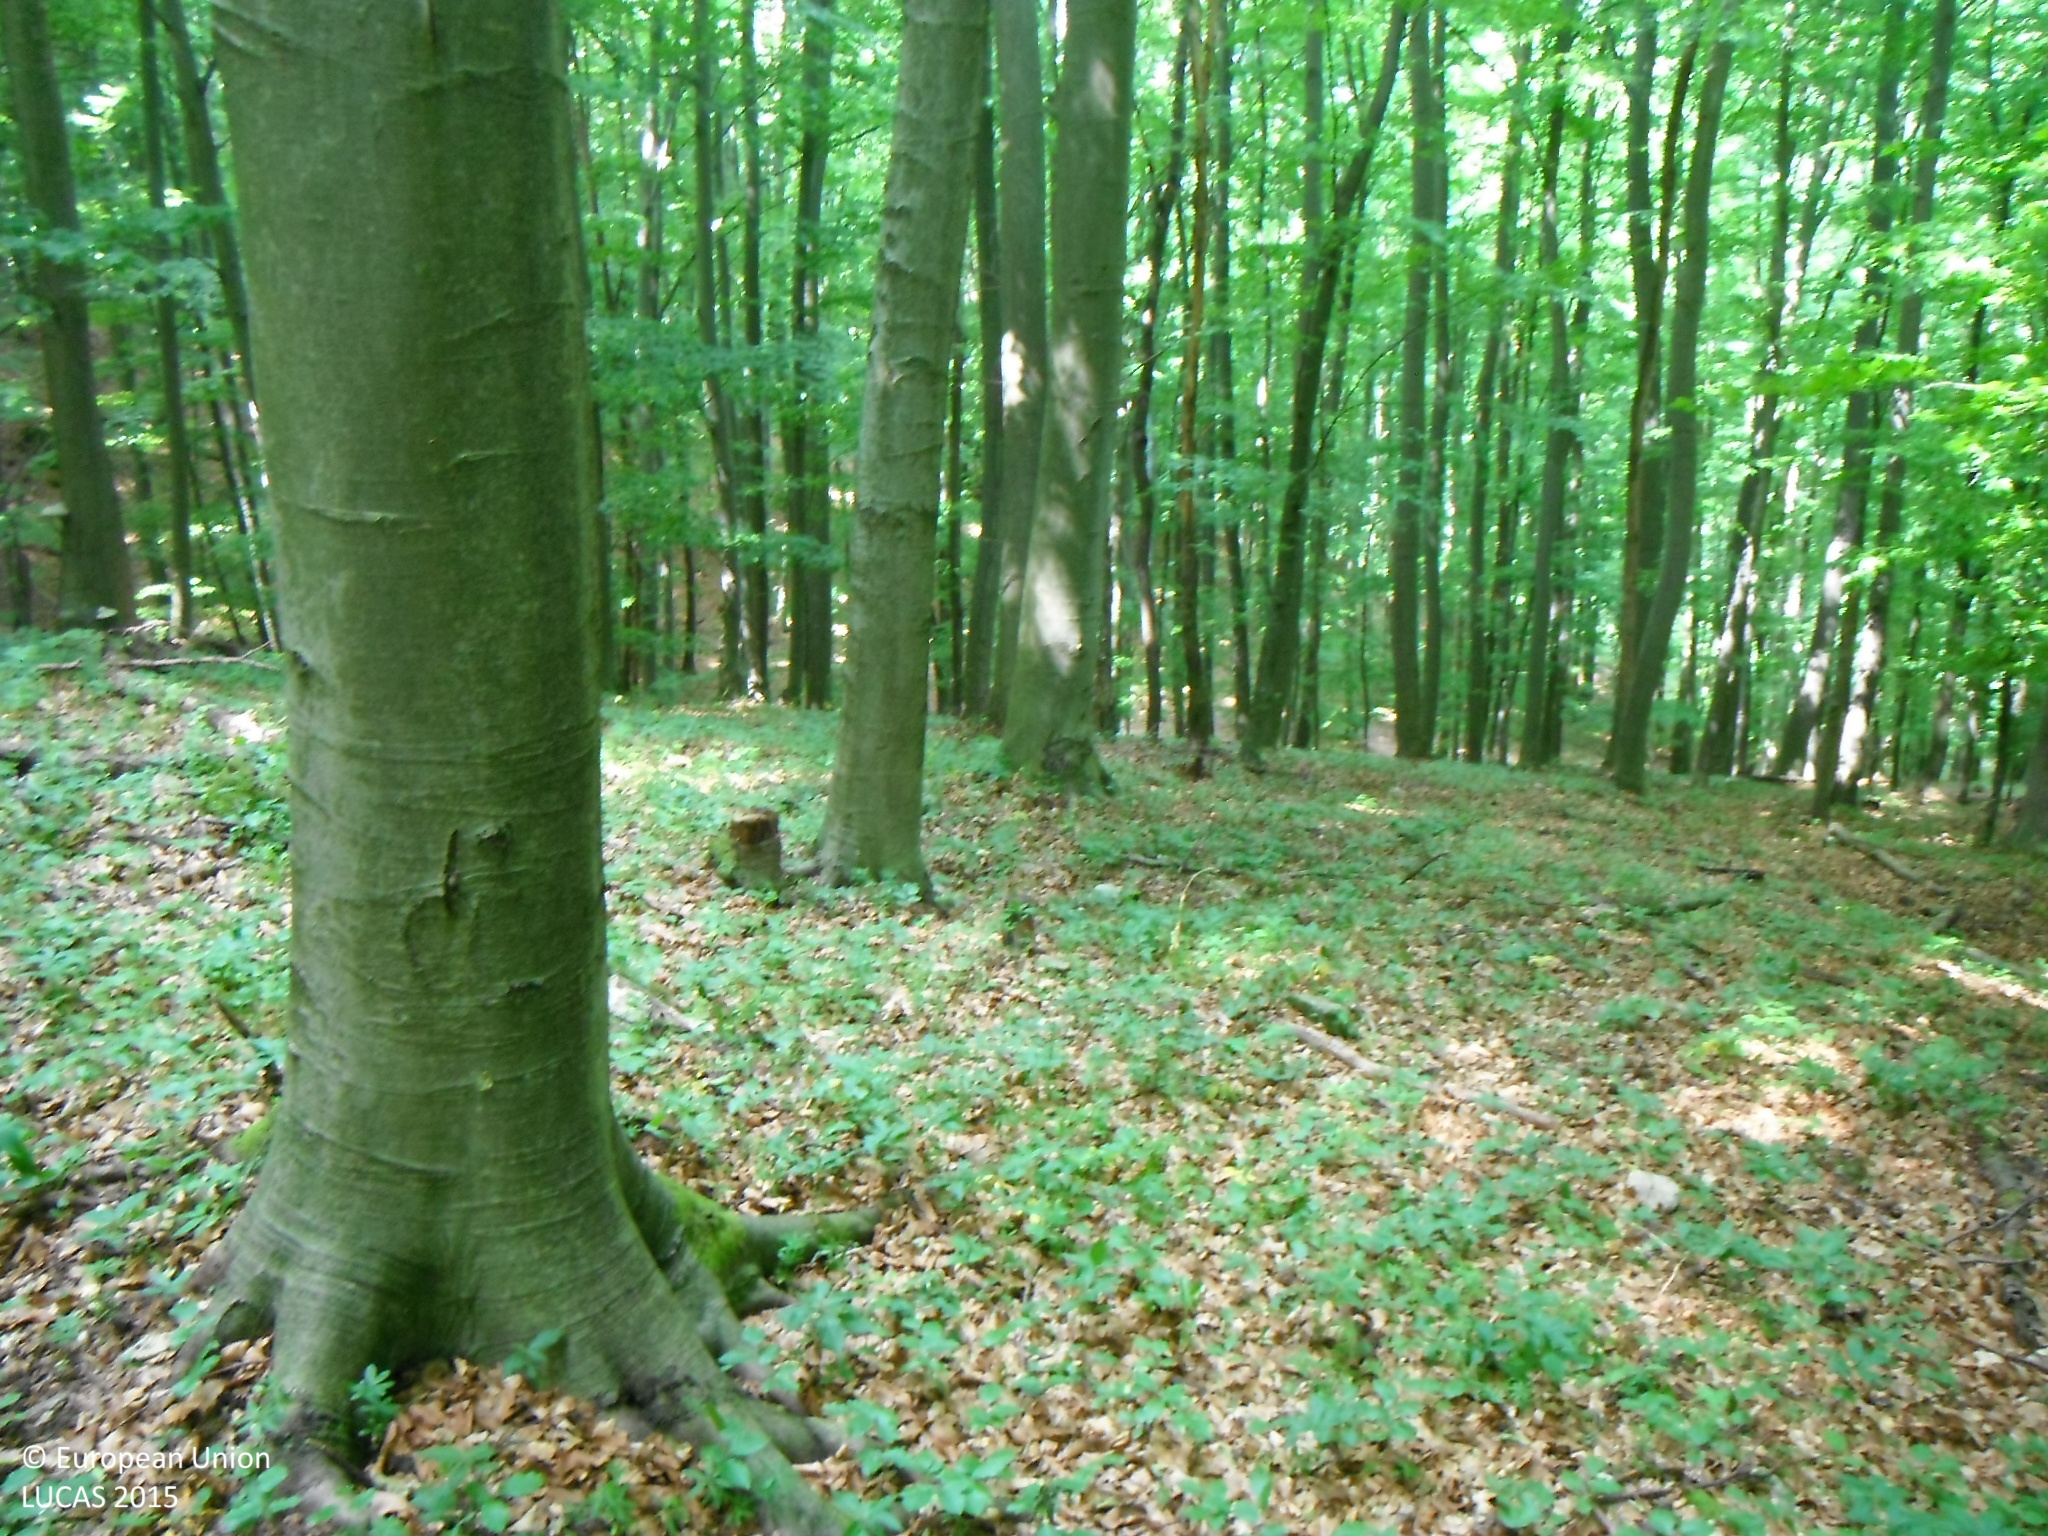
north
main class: Woodland
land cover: Broadleaved woodland
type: beech forest
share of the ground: > 75 %
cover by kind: broadleaved forest trees 95 %, herbaceous plants 5 %
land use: Forestry
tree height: > 5 m
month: June
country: SK
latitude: 48.4084
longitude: 19.5219
